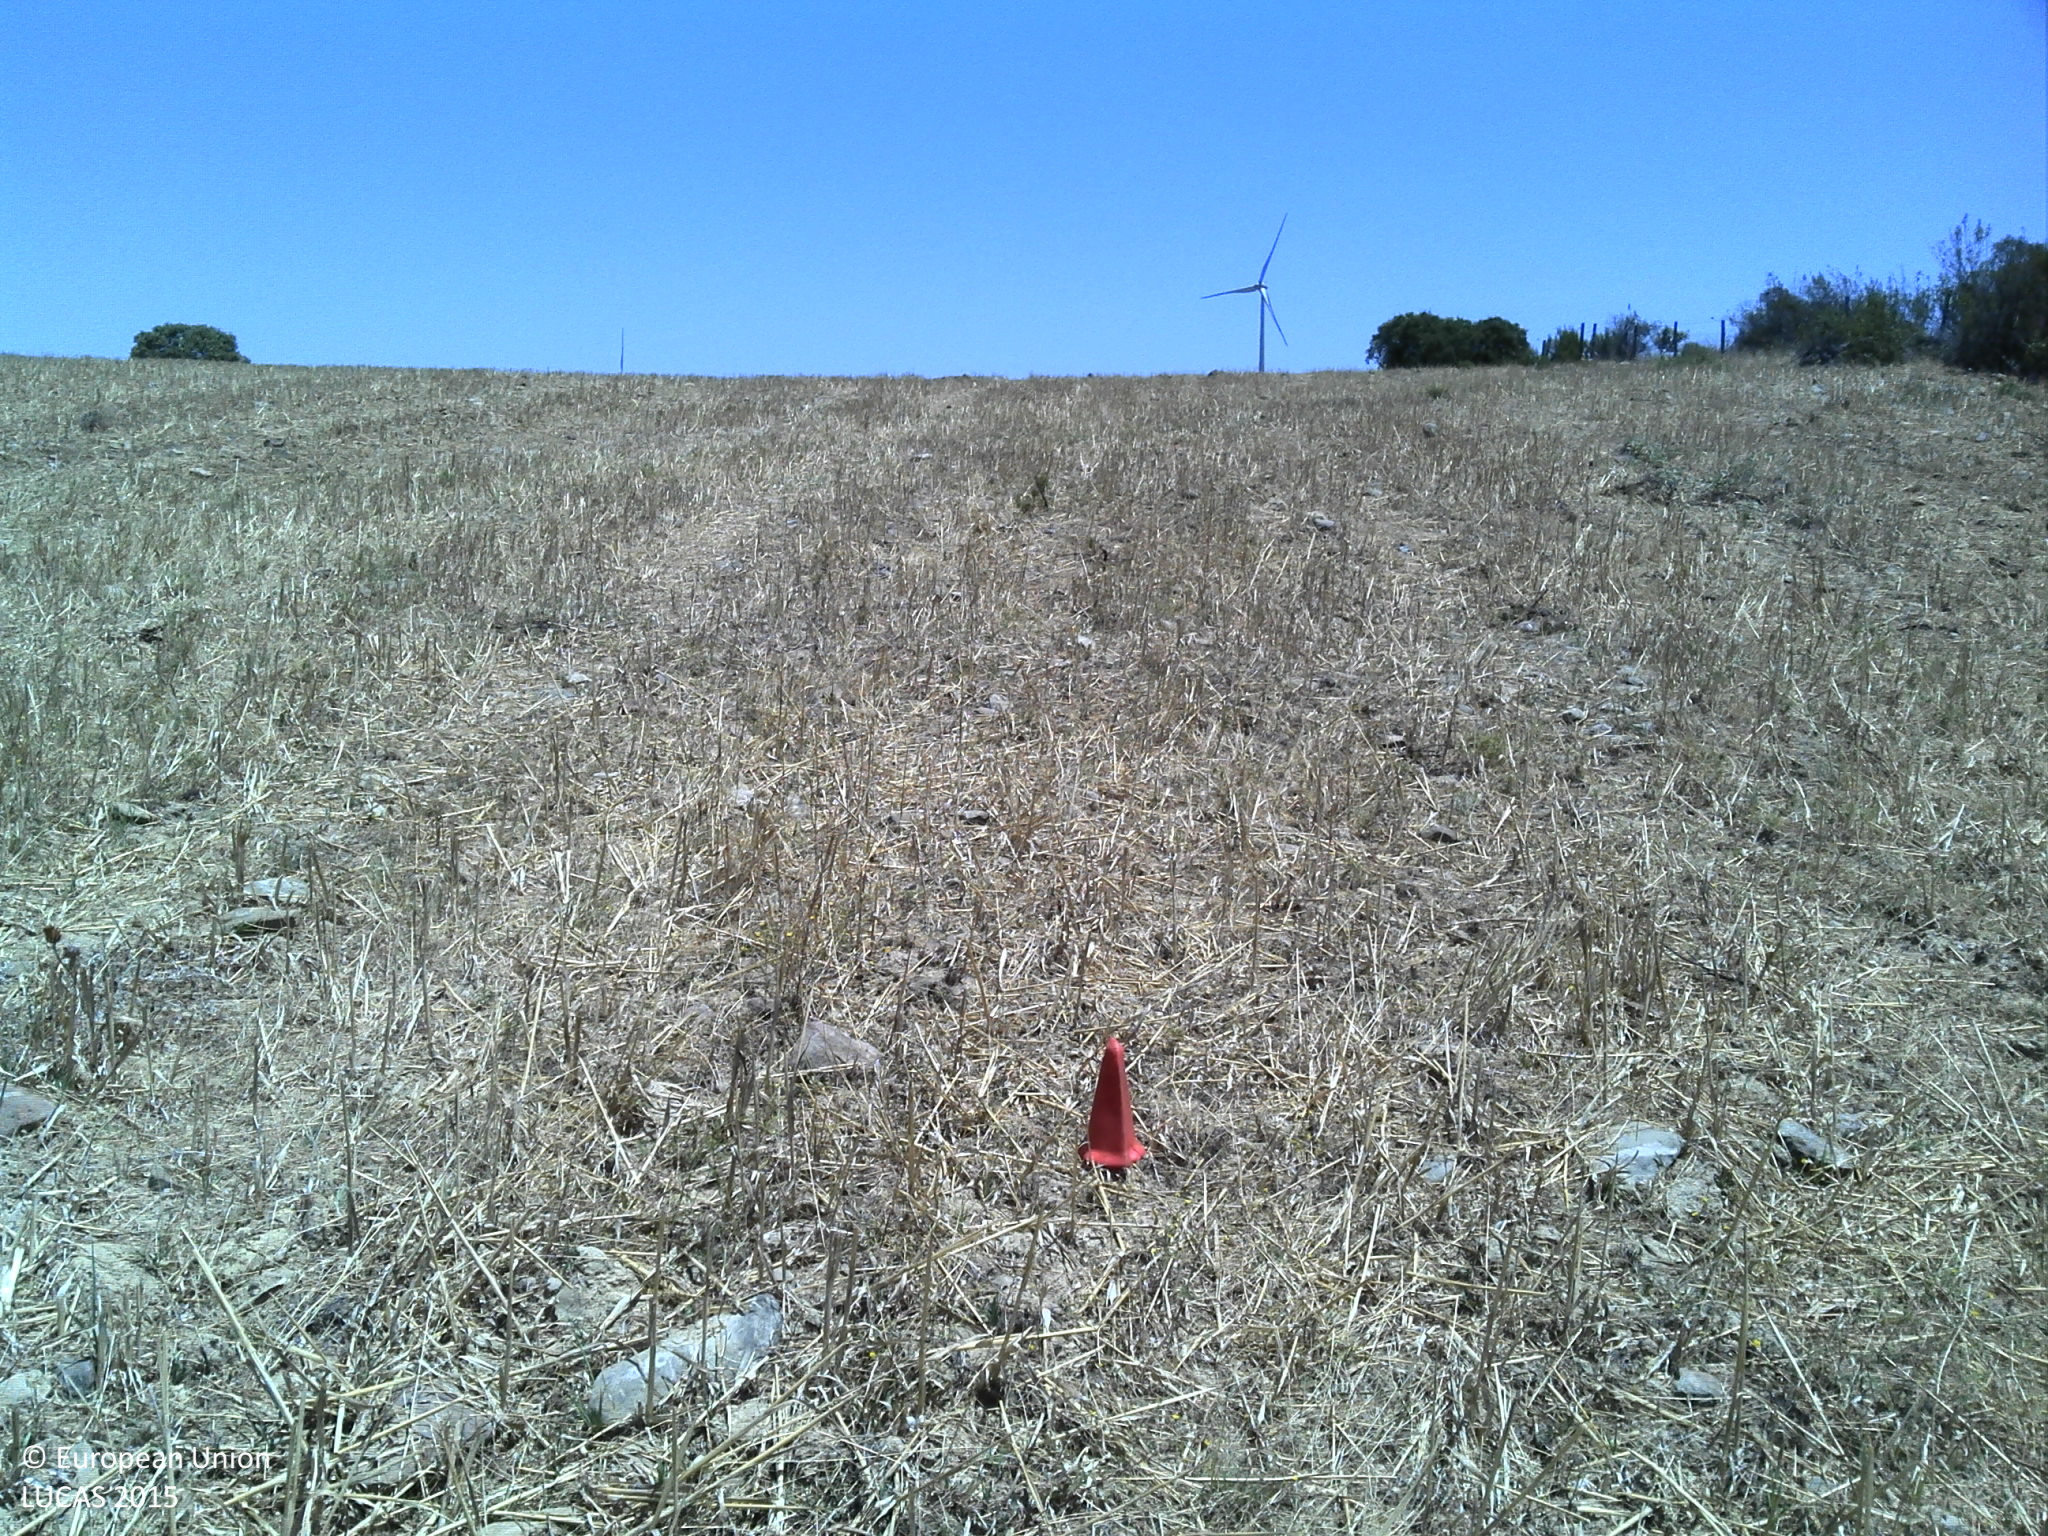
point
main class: Cropland
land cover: Oats
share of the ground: 50 - 75 %
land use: Agriculture (excluding fallow land and kitchen gardens)
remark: Harvested field
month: July
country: PT
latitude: 37.5047
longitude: -7.8566
